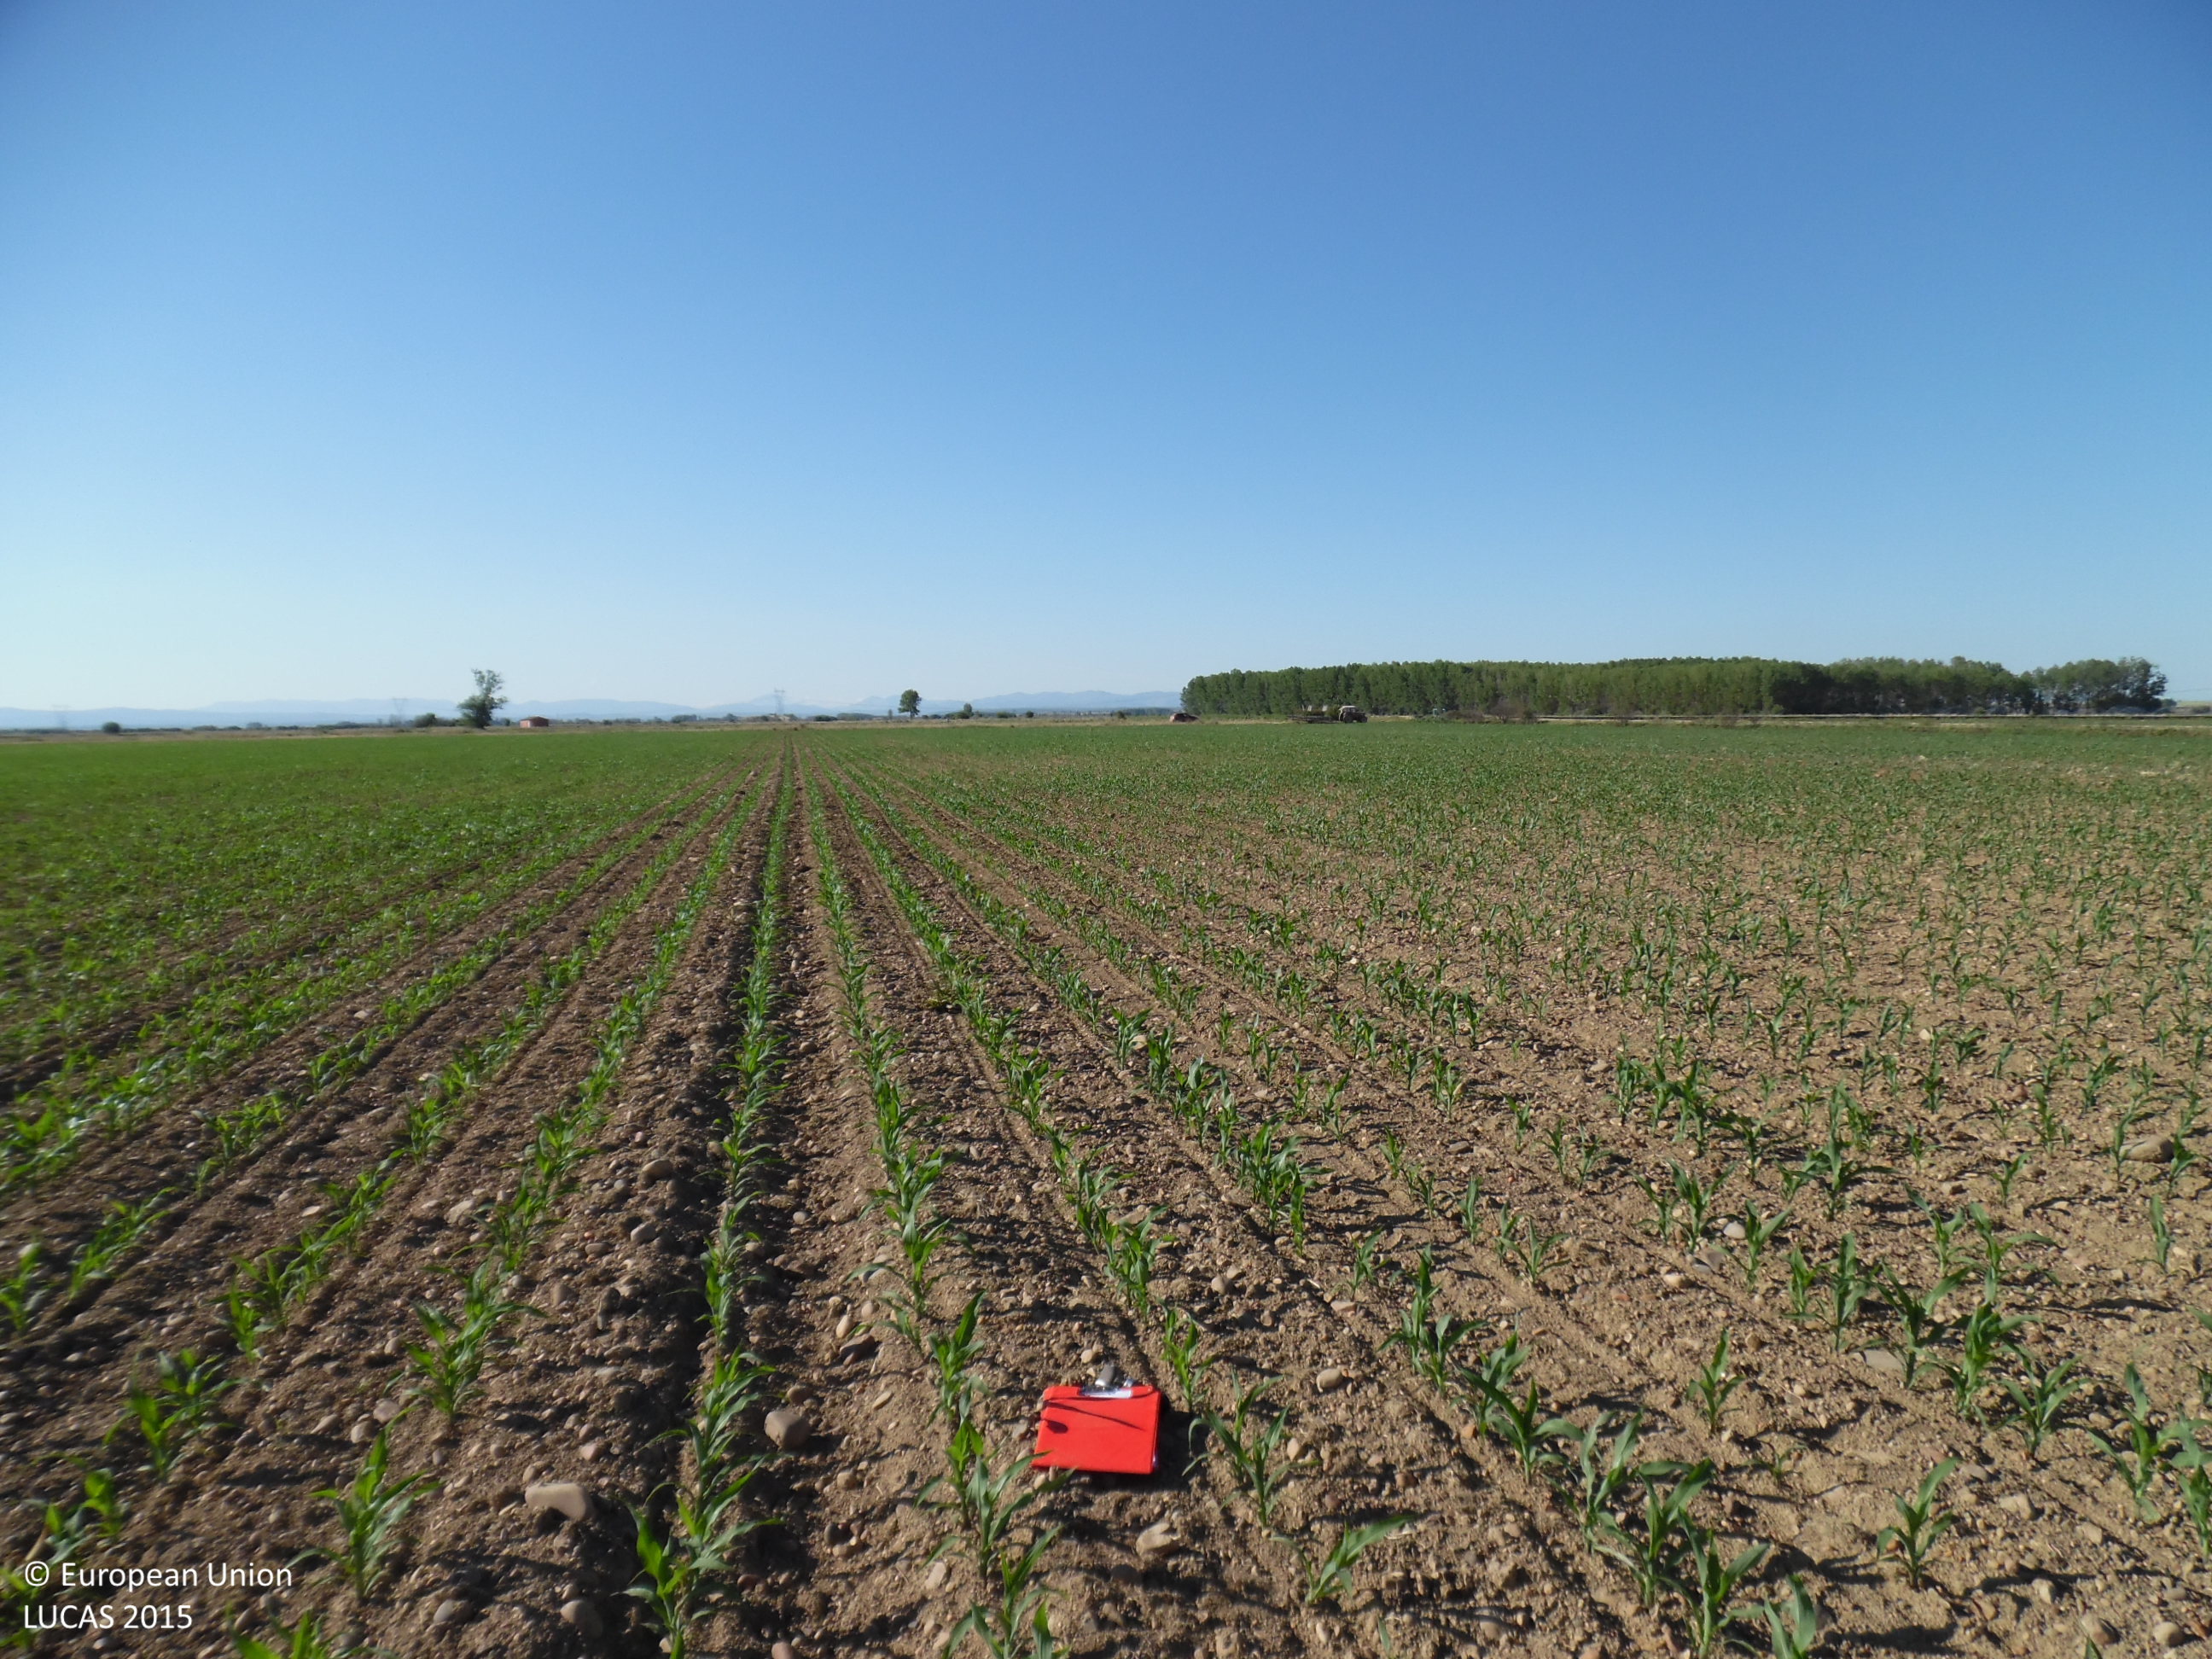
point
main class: Cropland
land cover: Maize
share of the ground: 25 - 50 %
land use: Agriculture (excluding fallow land and kitchen gardens)
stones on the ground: 10 - 25 %
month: June
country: ES
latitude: 42.4734
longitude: -5.7786
